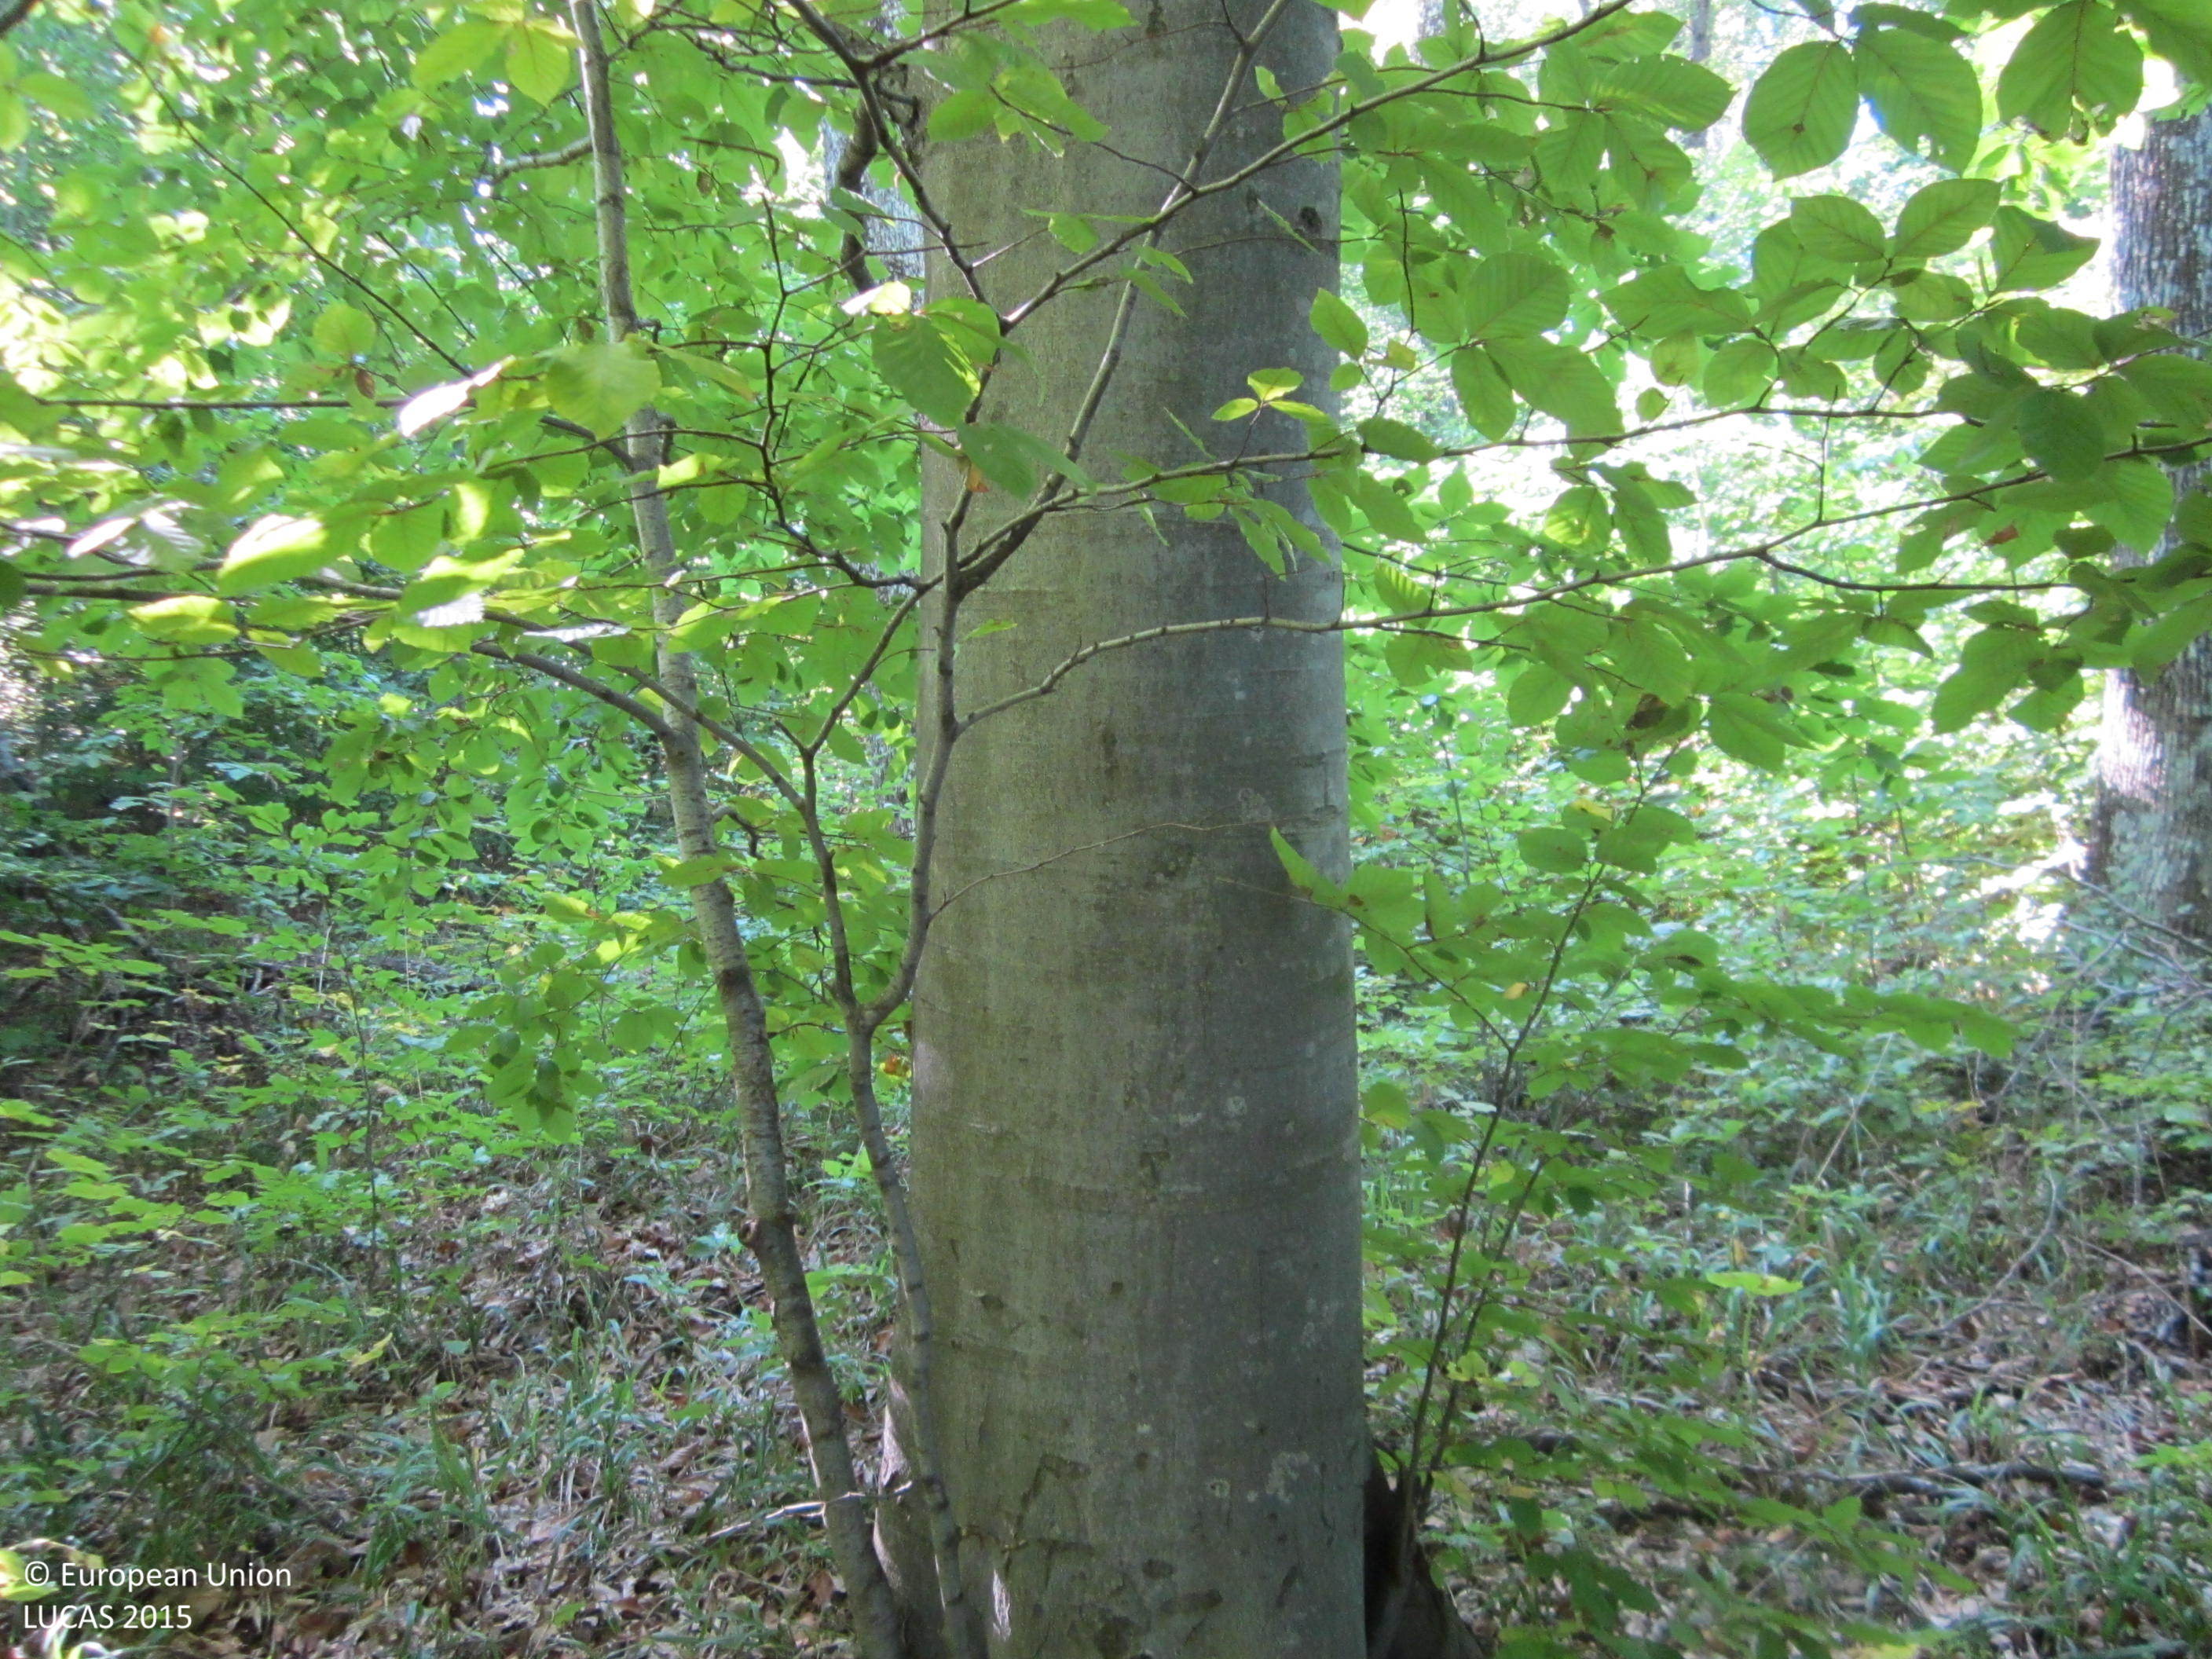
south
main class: Woodland
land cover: Broadleaved woodland
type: hemiboreal forest and nemoral coniferous forest and mixed broadleaved-coniferous forest
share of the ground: > 75 %
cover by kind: broadleaved forest trees 80 %, unconsolidated bare surface 10 %, shrubs 5 %, herbaceous plants 5 %
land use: Forestry
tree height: > 5 m
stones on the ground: < 10 %
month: October
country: BG
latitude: 42.9415
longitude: 26.6333
